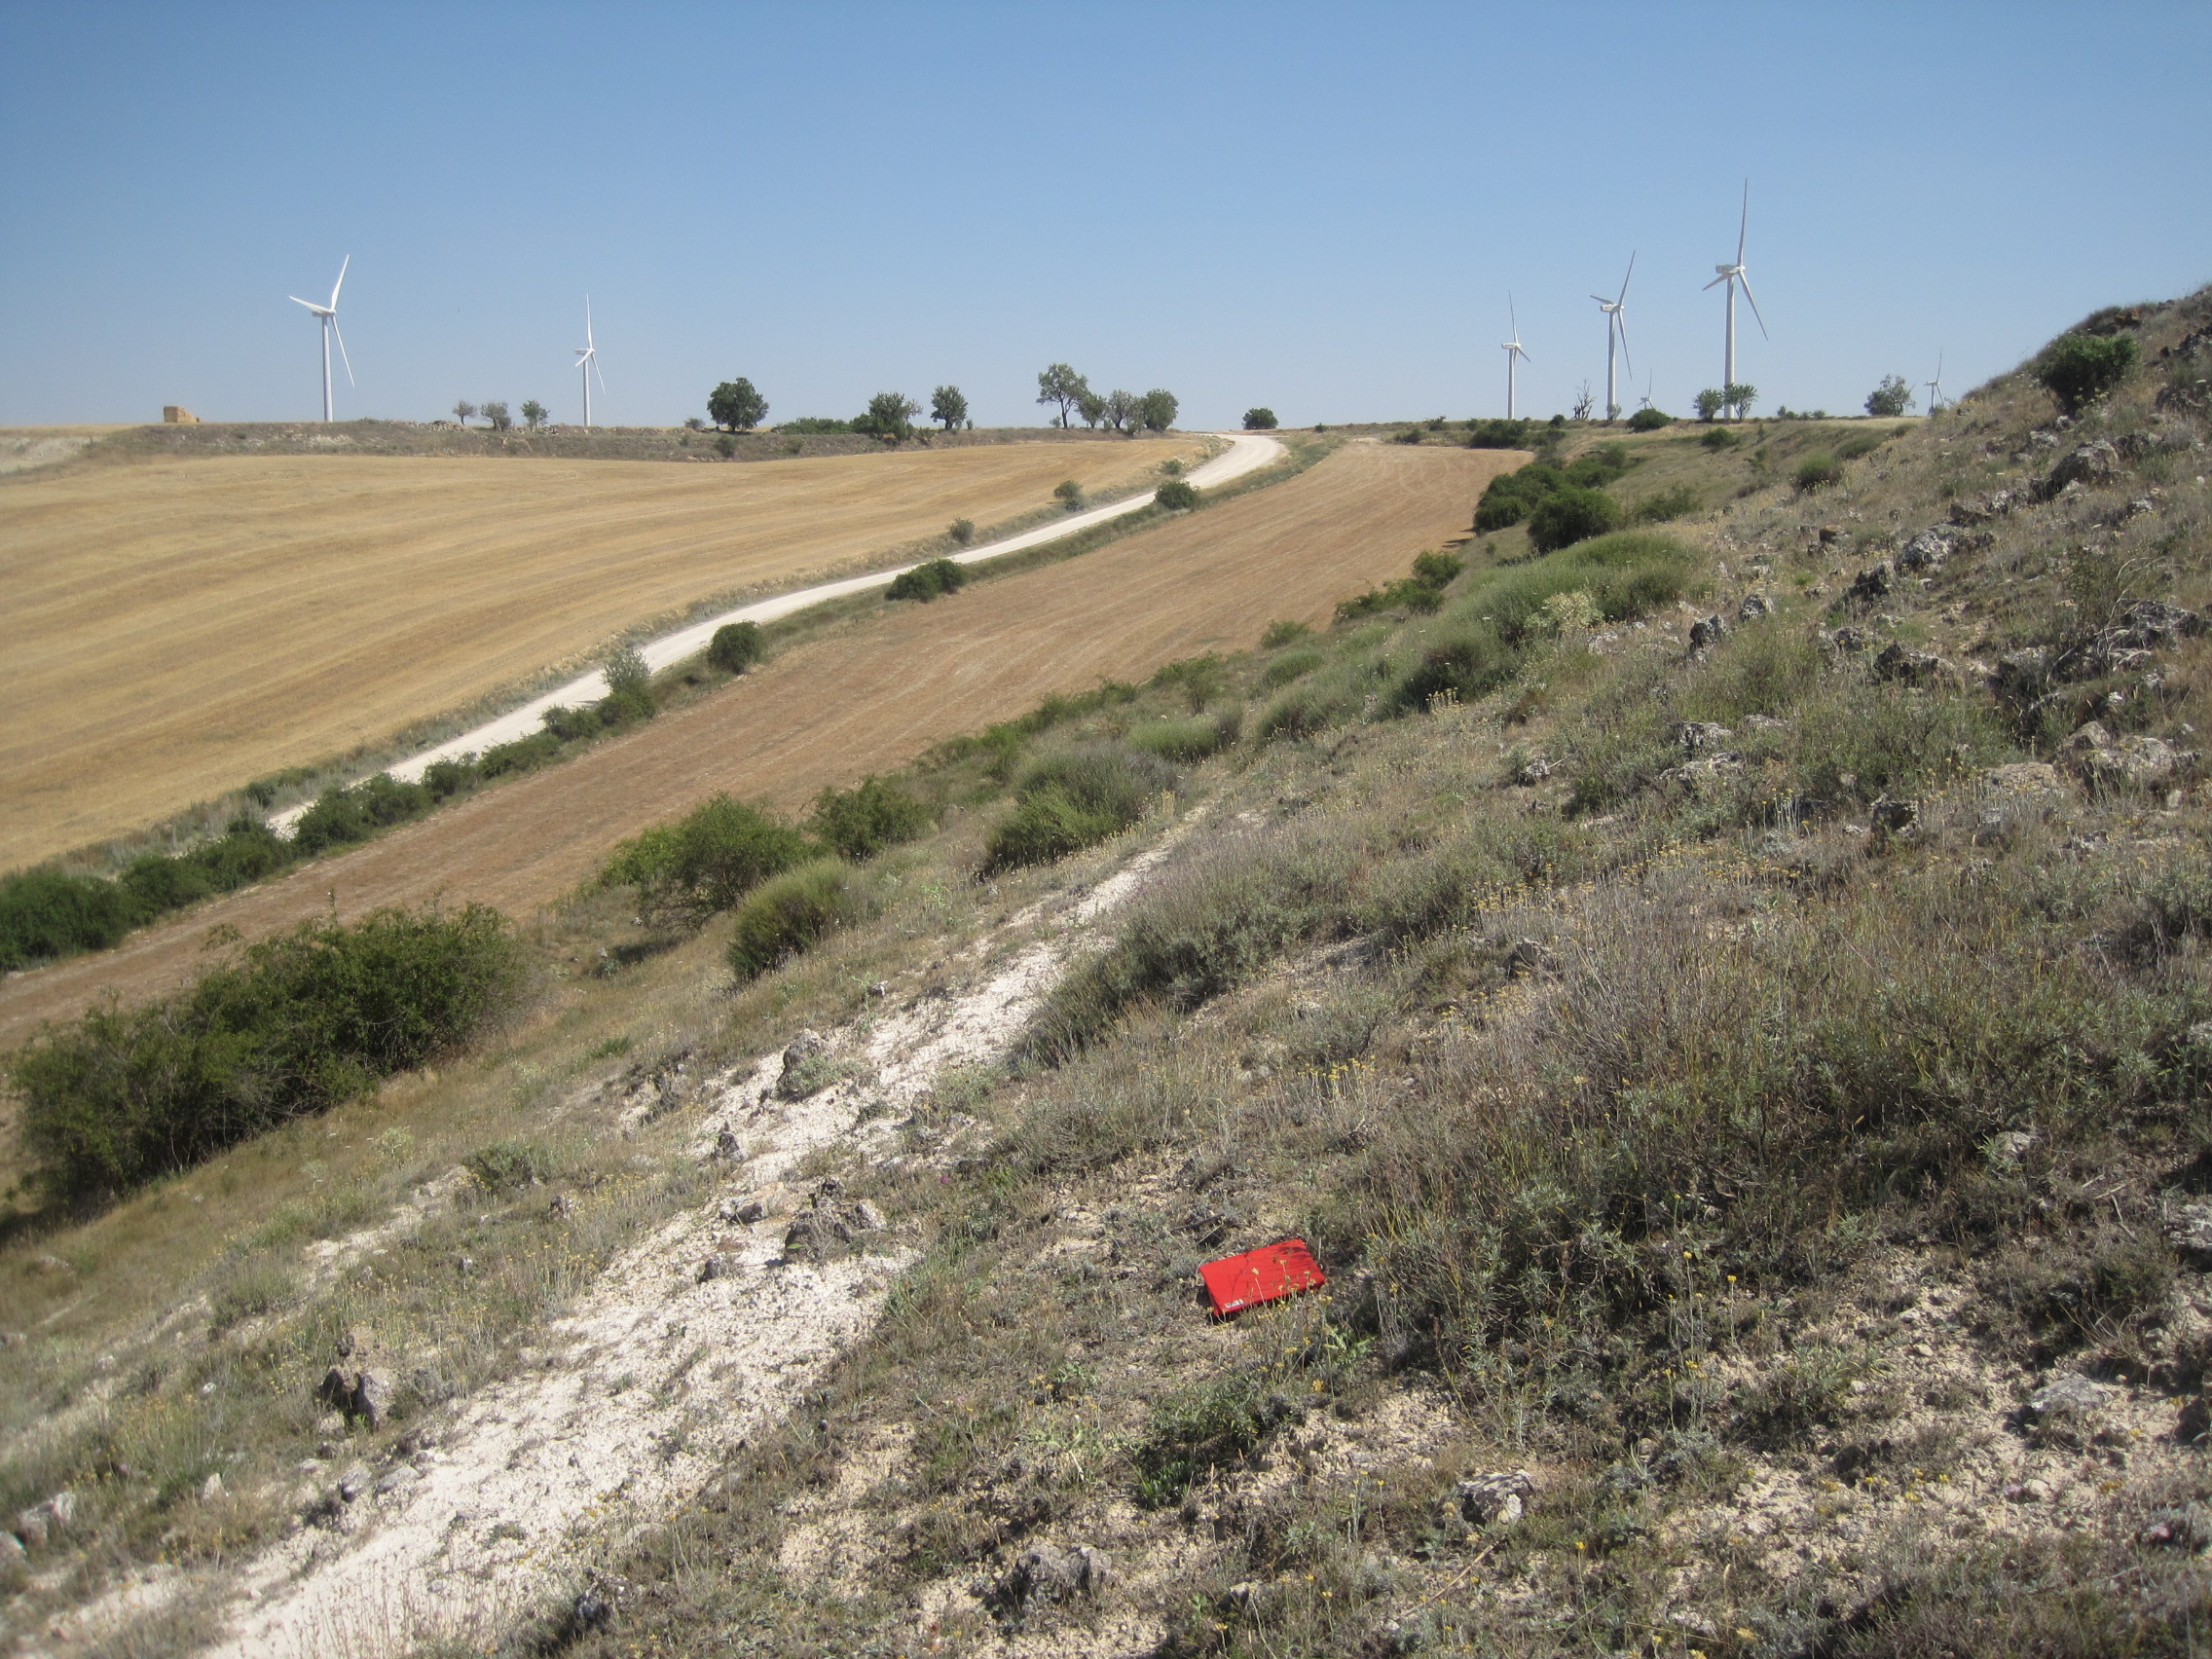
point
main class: Grassland
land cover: Grassland without tree/shrub cover
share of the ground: > 75 %
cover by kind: herbaceous plants 95 %, shrubs 5 %
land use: Semi-natural and natural areas not in use
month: July
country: ES
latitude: 41.9126
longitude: -4.7698
